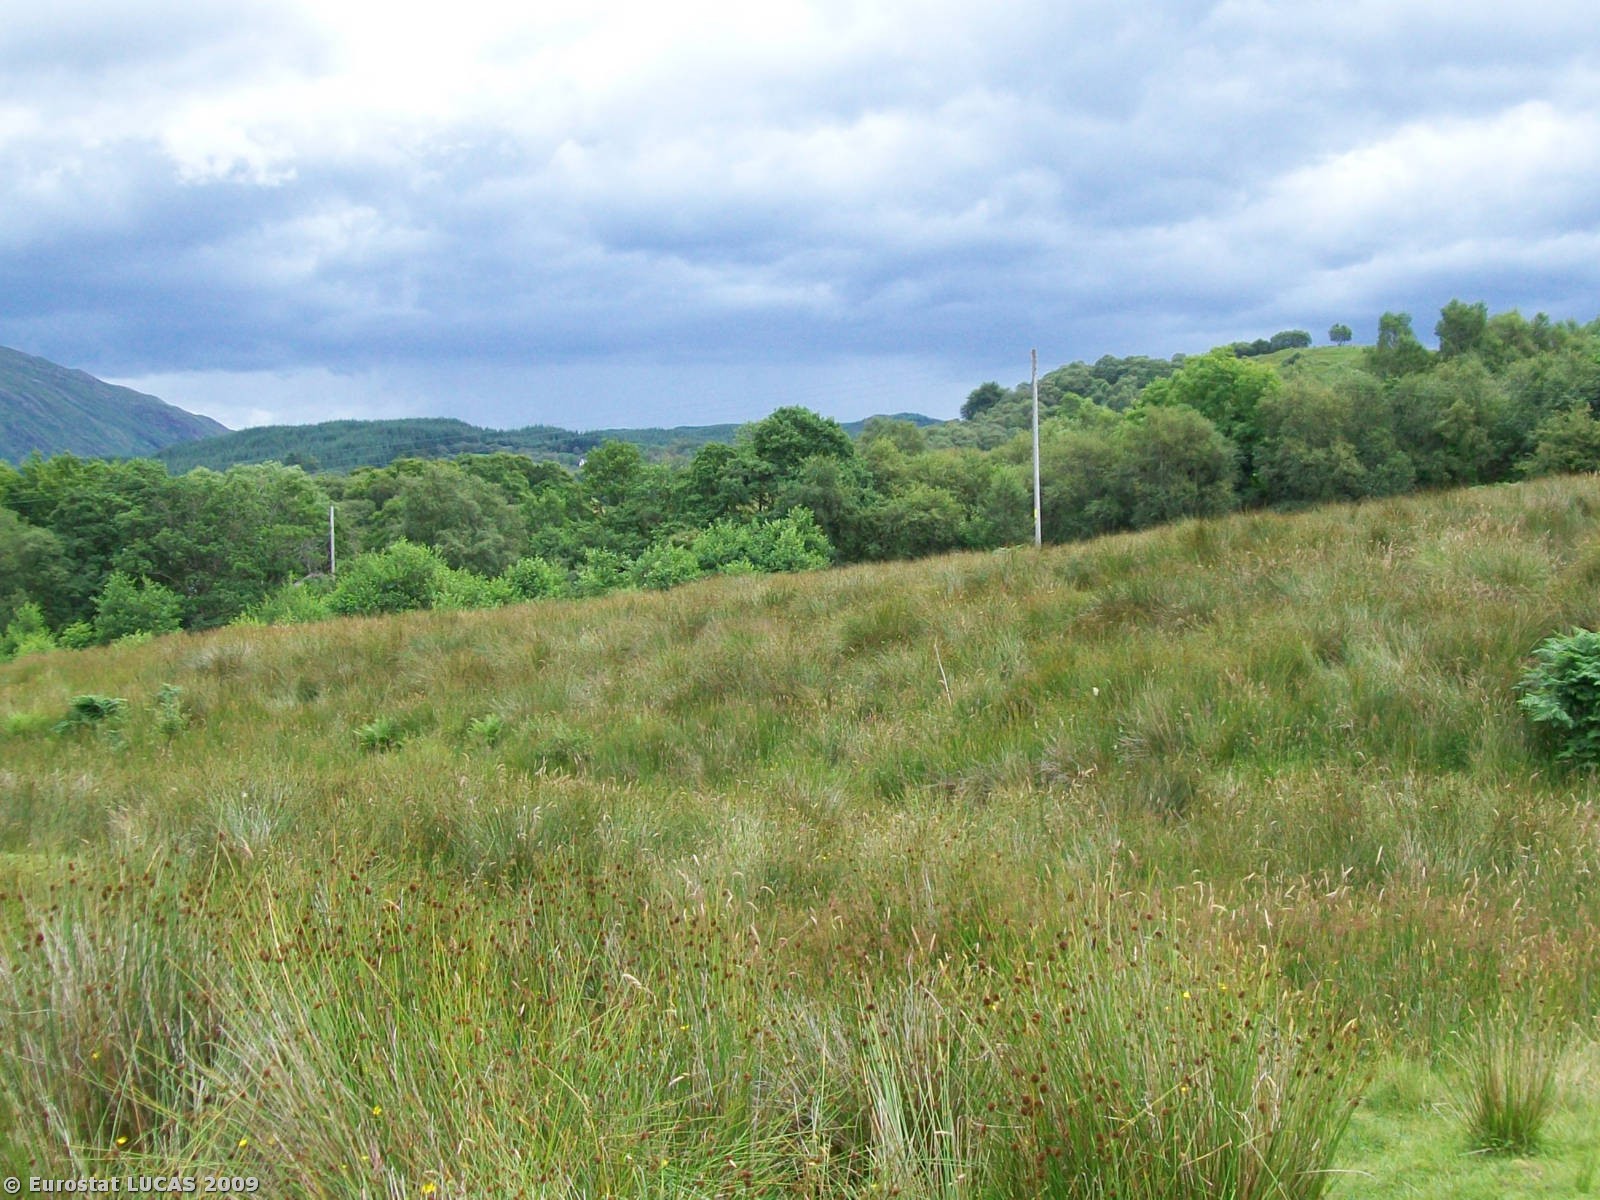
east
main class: Grassland
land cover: Grassland without tree/shrub cover
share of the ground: > 75 %
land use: Agriculture (excluding fallow land and kitchen gardens)
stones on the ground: 10 - 25 %
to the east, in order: Grassland without tree/shrub cover; Grassland with sparse tree/shrub cover; Broadleaved woodland; Rivers and streams; Broadleaved woodland; Fences; Grass margins; Paved roads, cycling and walking lanes; Grass margins; Artificial constructions in urban areas; Grassland without tree/shrub cover
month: July
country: GB
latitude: 56.4250
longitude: -5.2409
